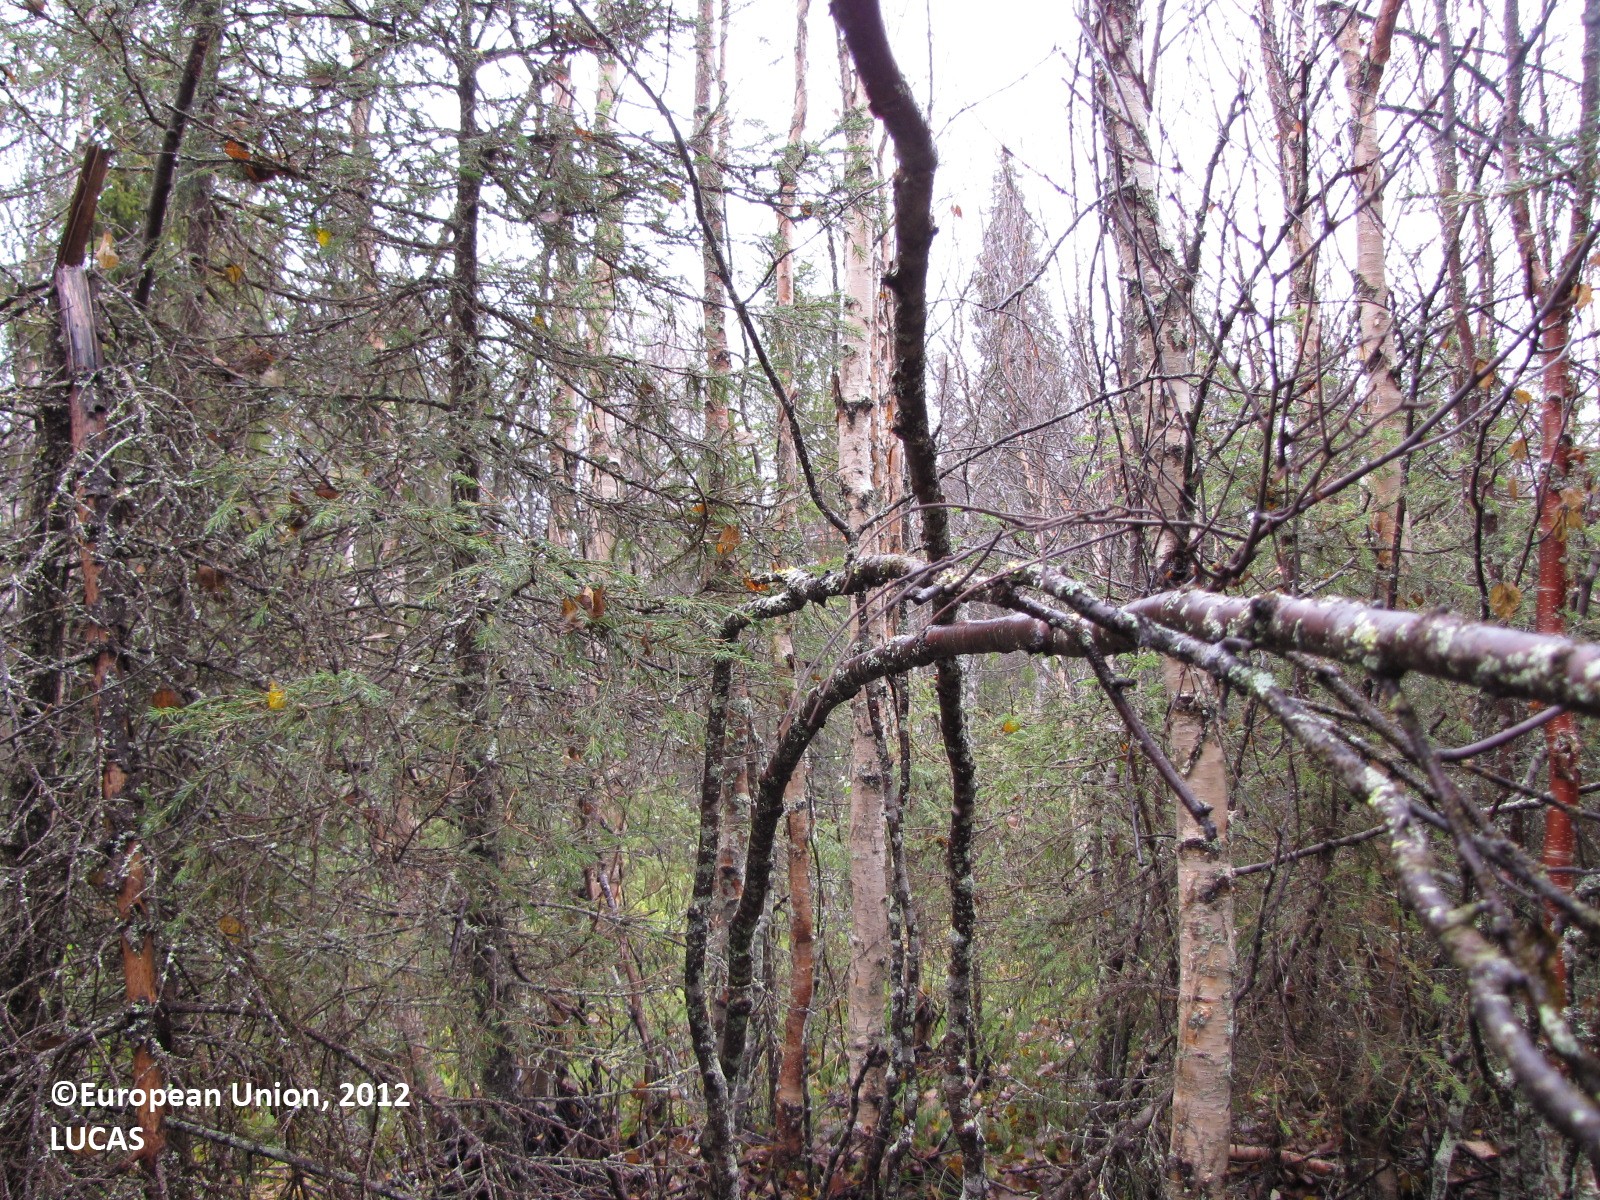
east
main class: Woodland
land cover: Spruce dominated mixed woodland
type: boreal forest
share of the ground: 50 - 75 %
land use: Forestry
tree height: > 5 m
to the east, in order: Spruce dominated mixed woodland; Rivers and streams; Spruce dominated mixed woodland; Ditches and canals; Spruce dominated mixed woodland; Pine dominated mixed woodland; Rocks and stones; Pine dominated mixed woodland
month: September
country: FI
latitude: 67.4975
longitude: 25.3351
